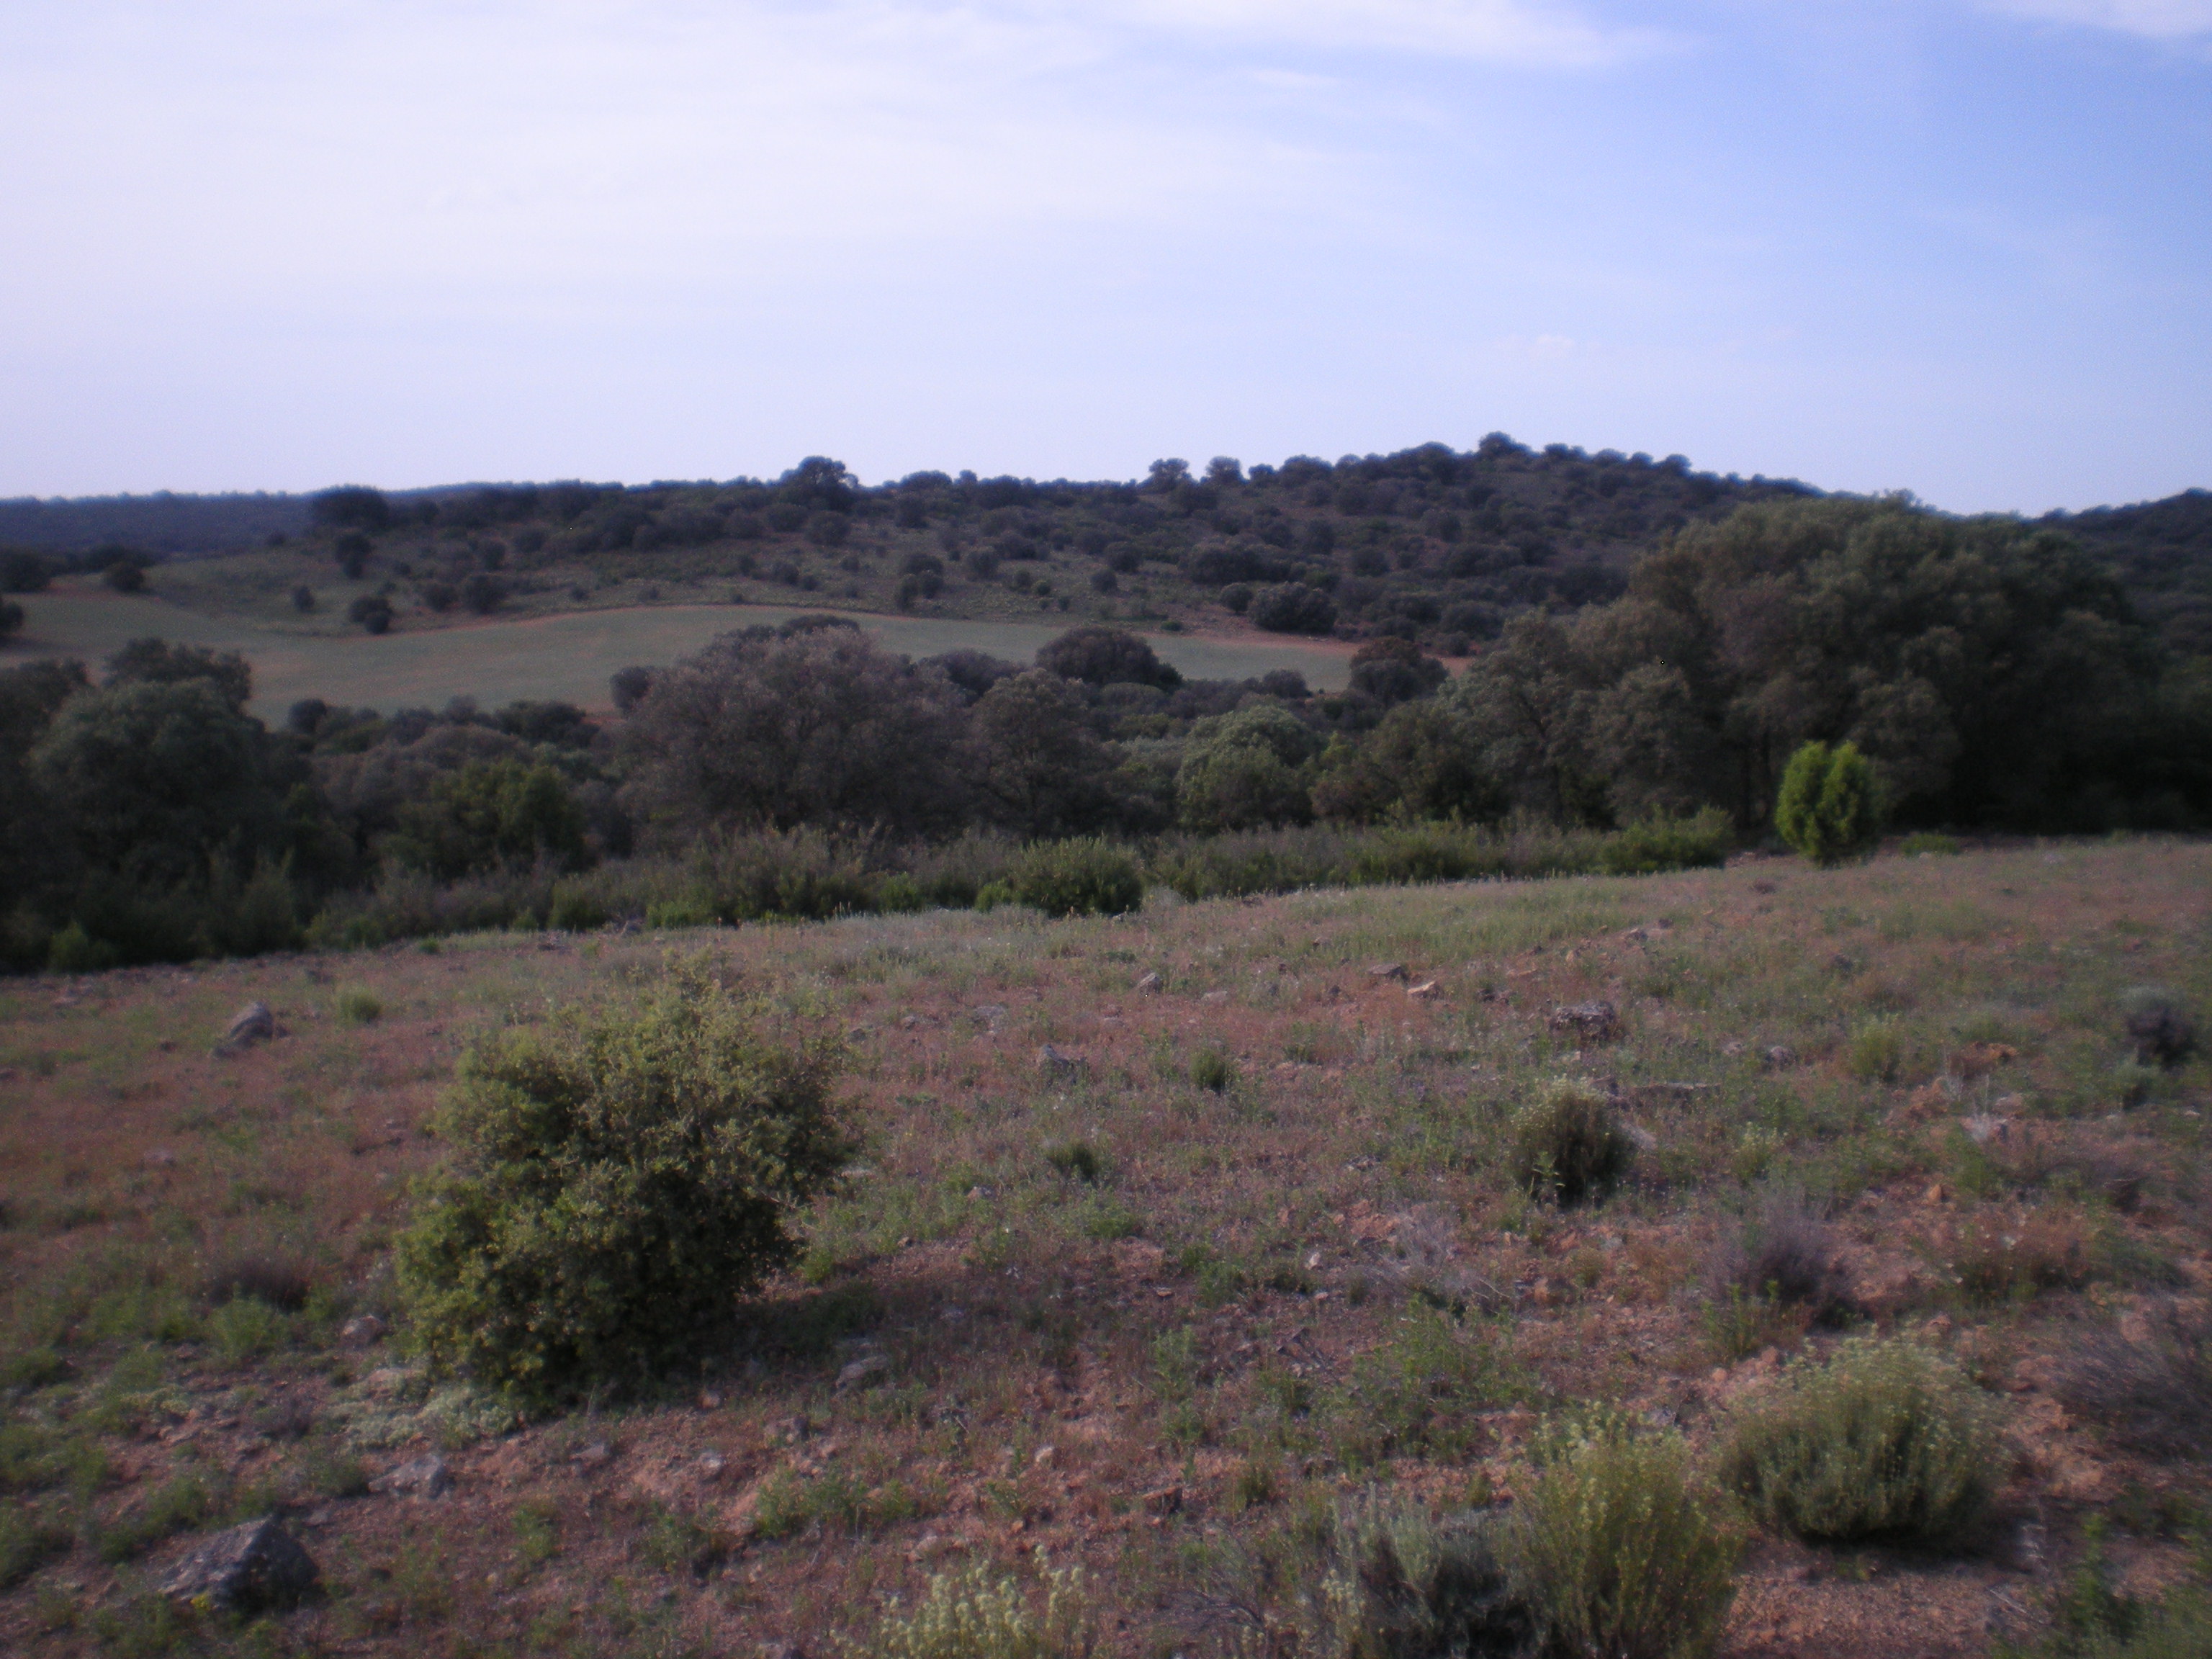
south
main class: Shrubland
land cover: Shrubland with sparse tree cover
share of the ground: 25 - 50 %
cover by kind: unconsolidated bare surface 40 %, herbaceous plants 35 %, shrubs 20 %, broadleaved forest trees 5 %
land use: Semi-natural and natural areas not in use
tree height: < 5 m
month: May
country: ES
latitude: 39.0018
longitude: -2.9541
